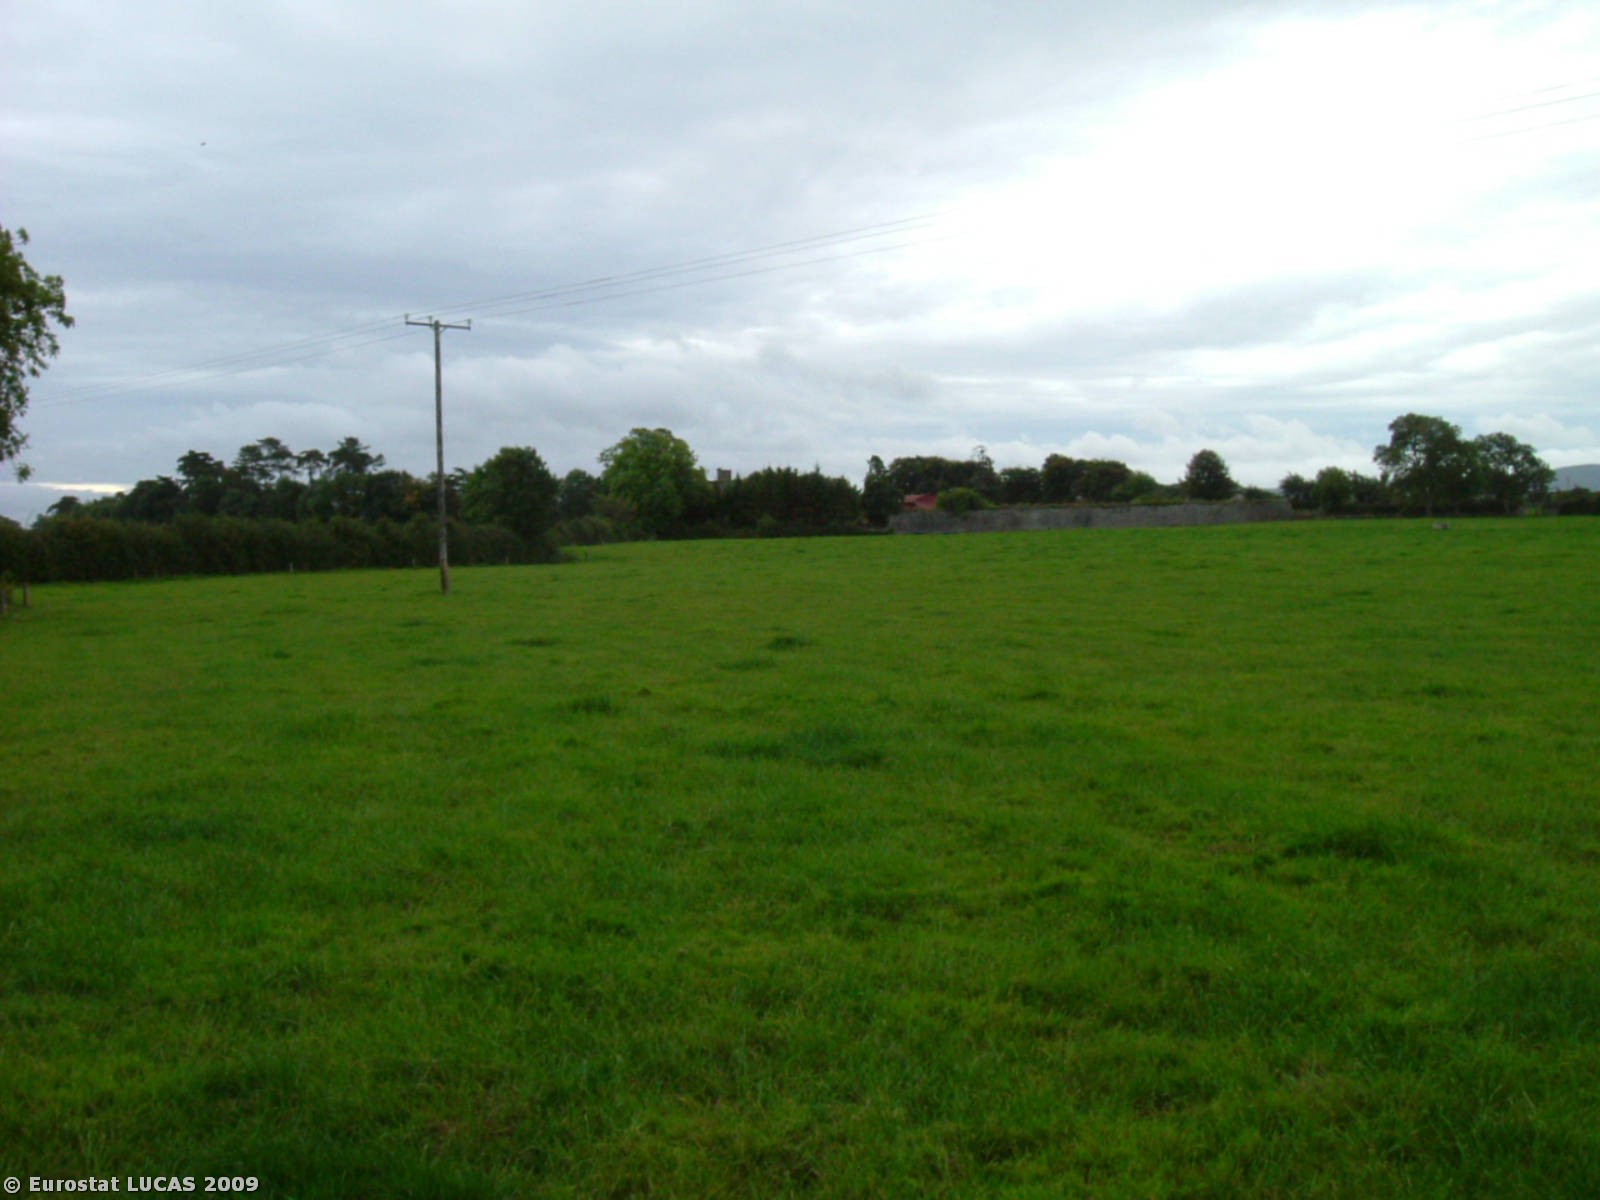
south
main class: Grassland
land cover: Grassland without tree/shrub cover
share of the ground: > 75 %
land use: Agriculture (excluding fallow land and kitchen gardens)
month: September
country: IE
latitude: 52.8677
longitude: -8.2331
